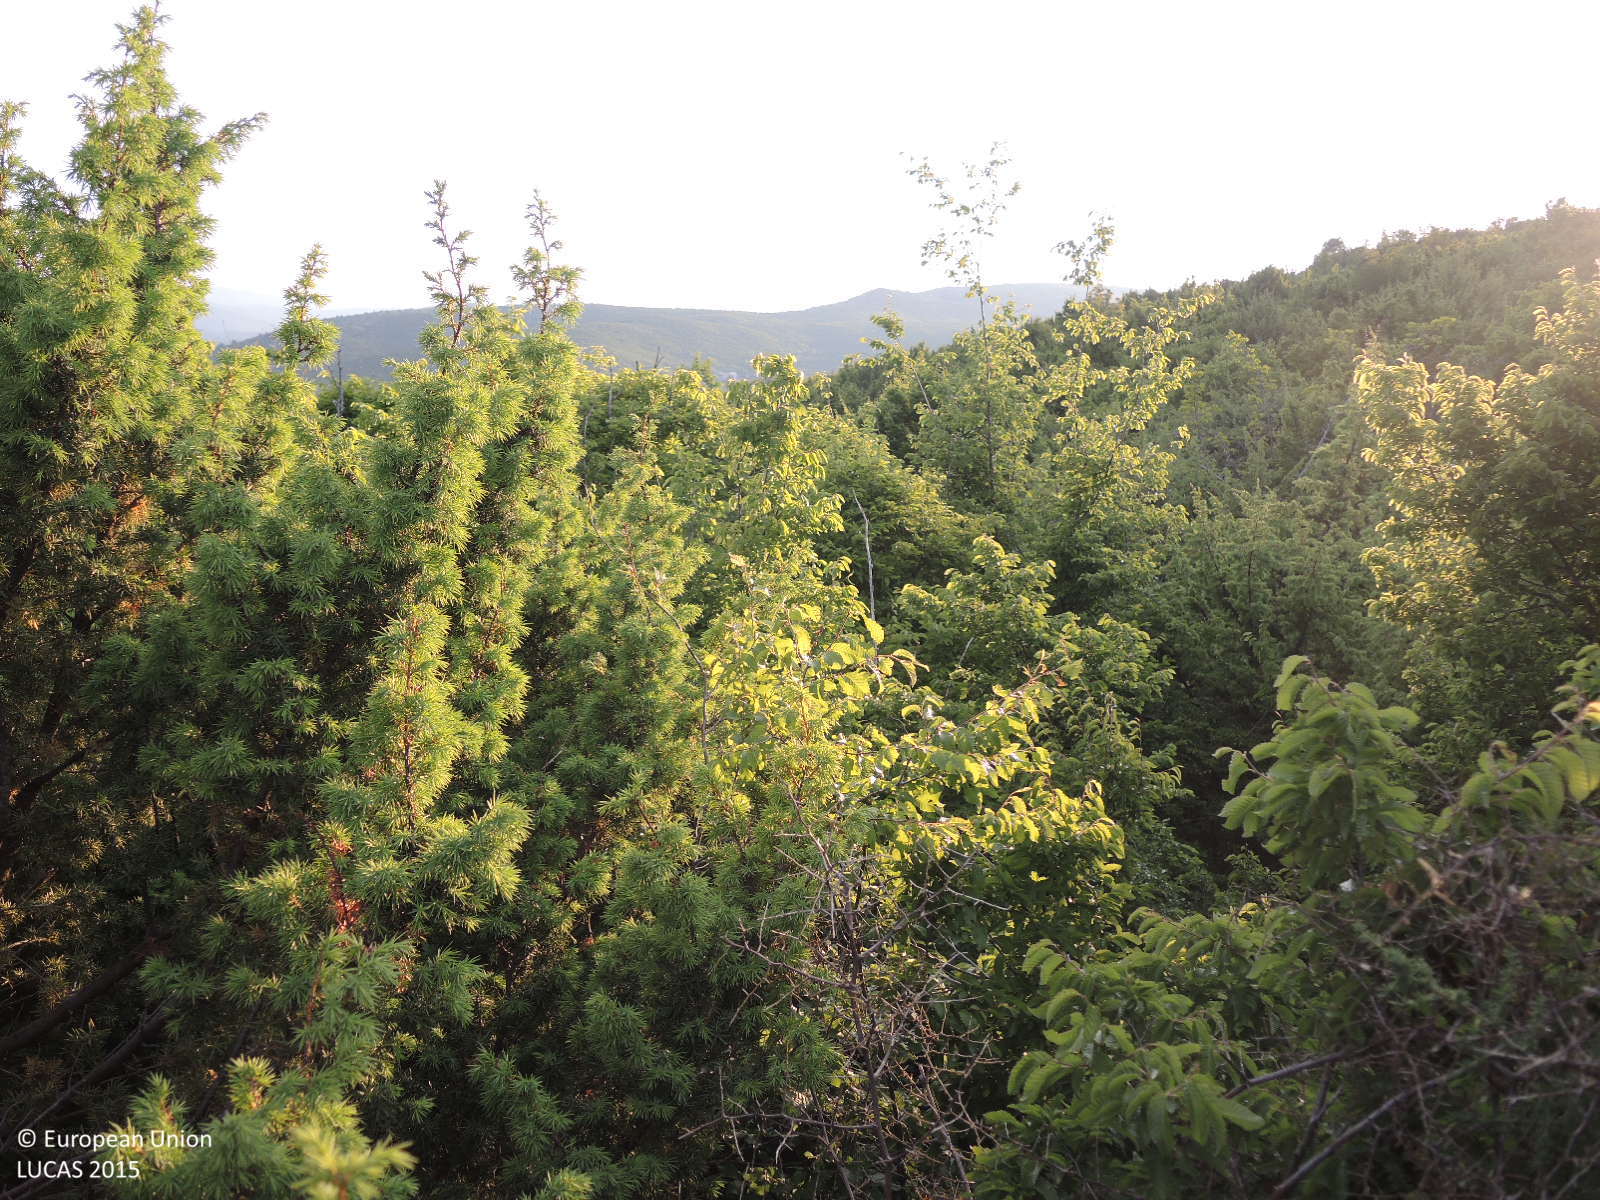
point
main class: Shrubland
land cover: Shrubland with sparse tree cover
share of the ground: > 75 %
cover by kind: shrubs 70 %, consolidated bare surface 10 %, unconsolidated bare surface 10 %, broadleaved forest trees 5 %, herbaceous plants 5 %
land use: Semi-natural and natural areas not in use
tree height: < 5 m
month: June
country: HR
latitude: 43.6719
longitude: 16.2794
